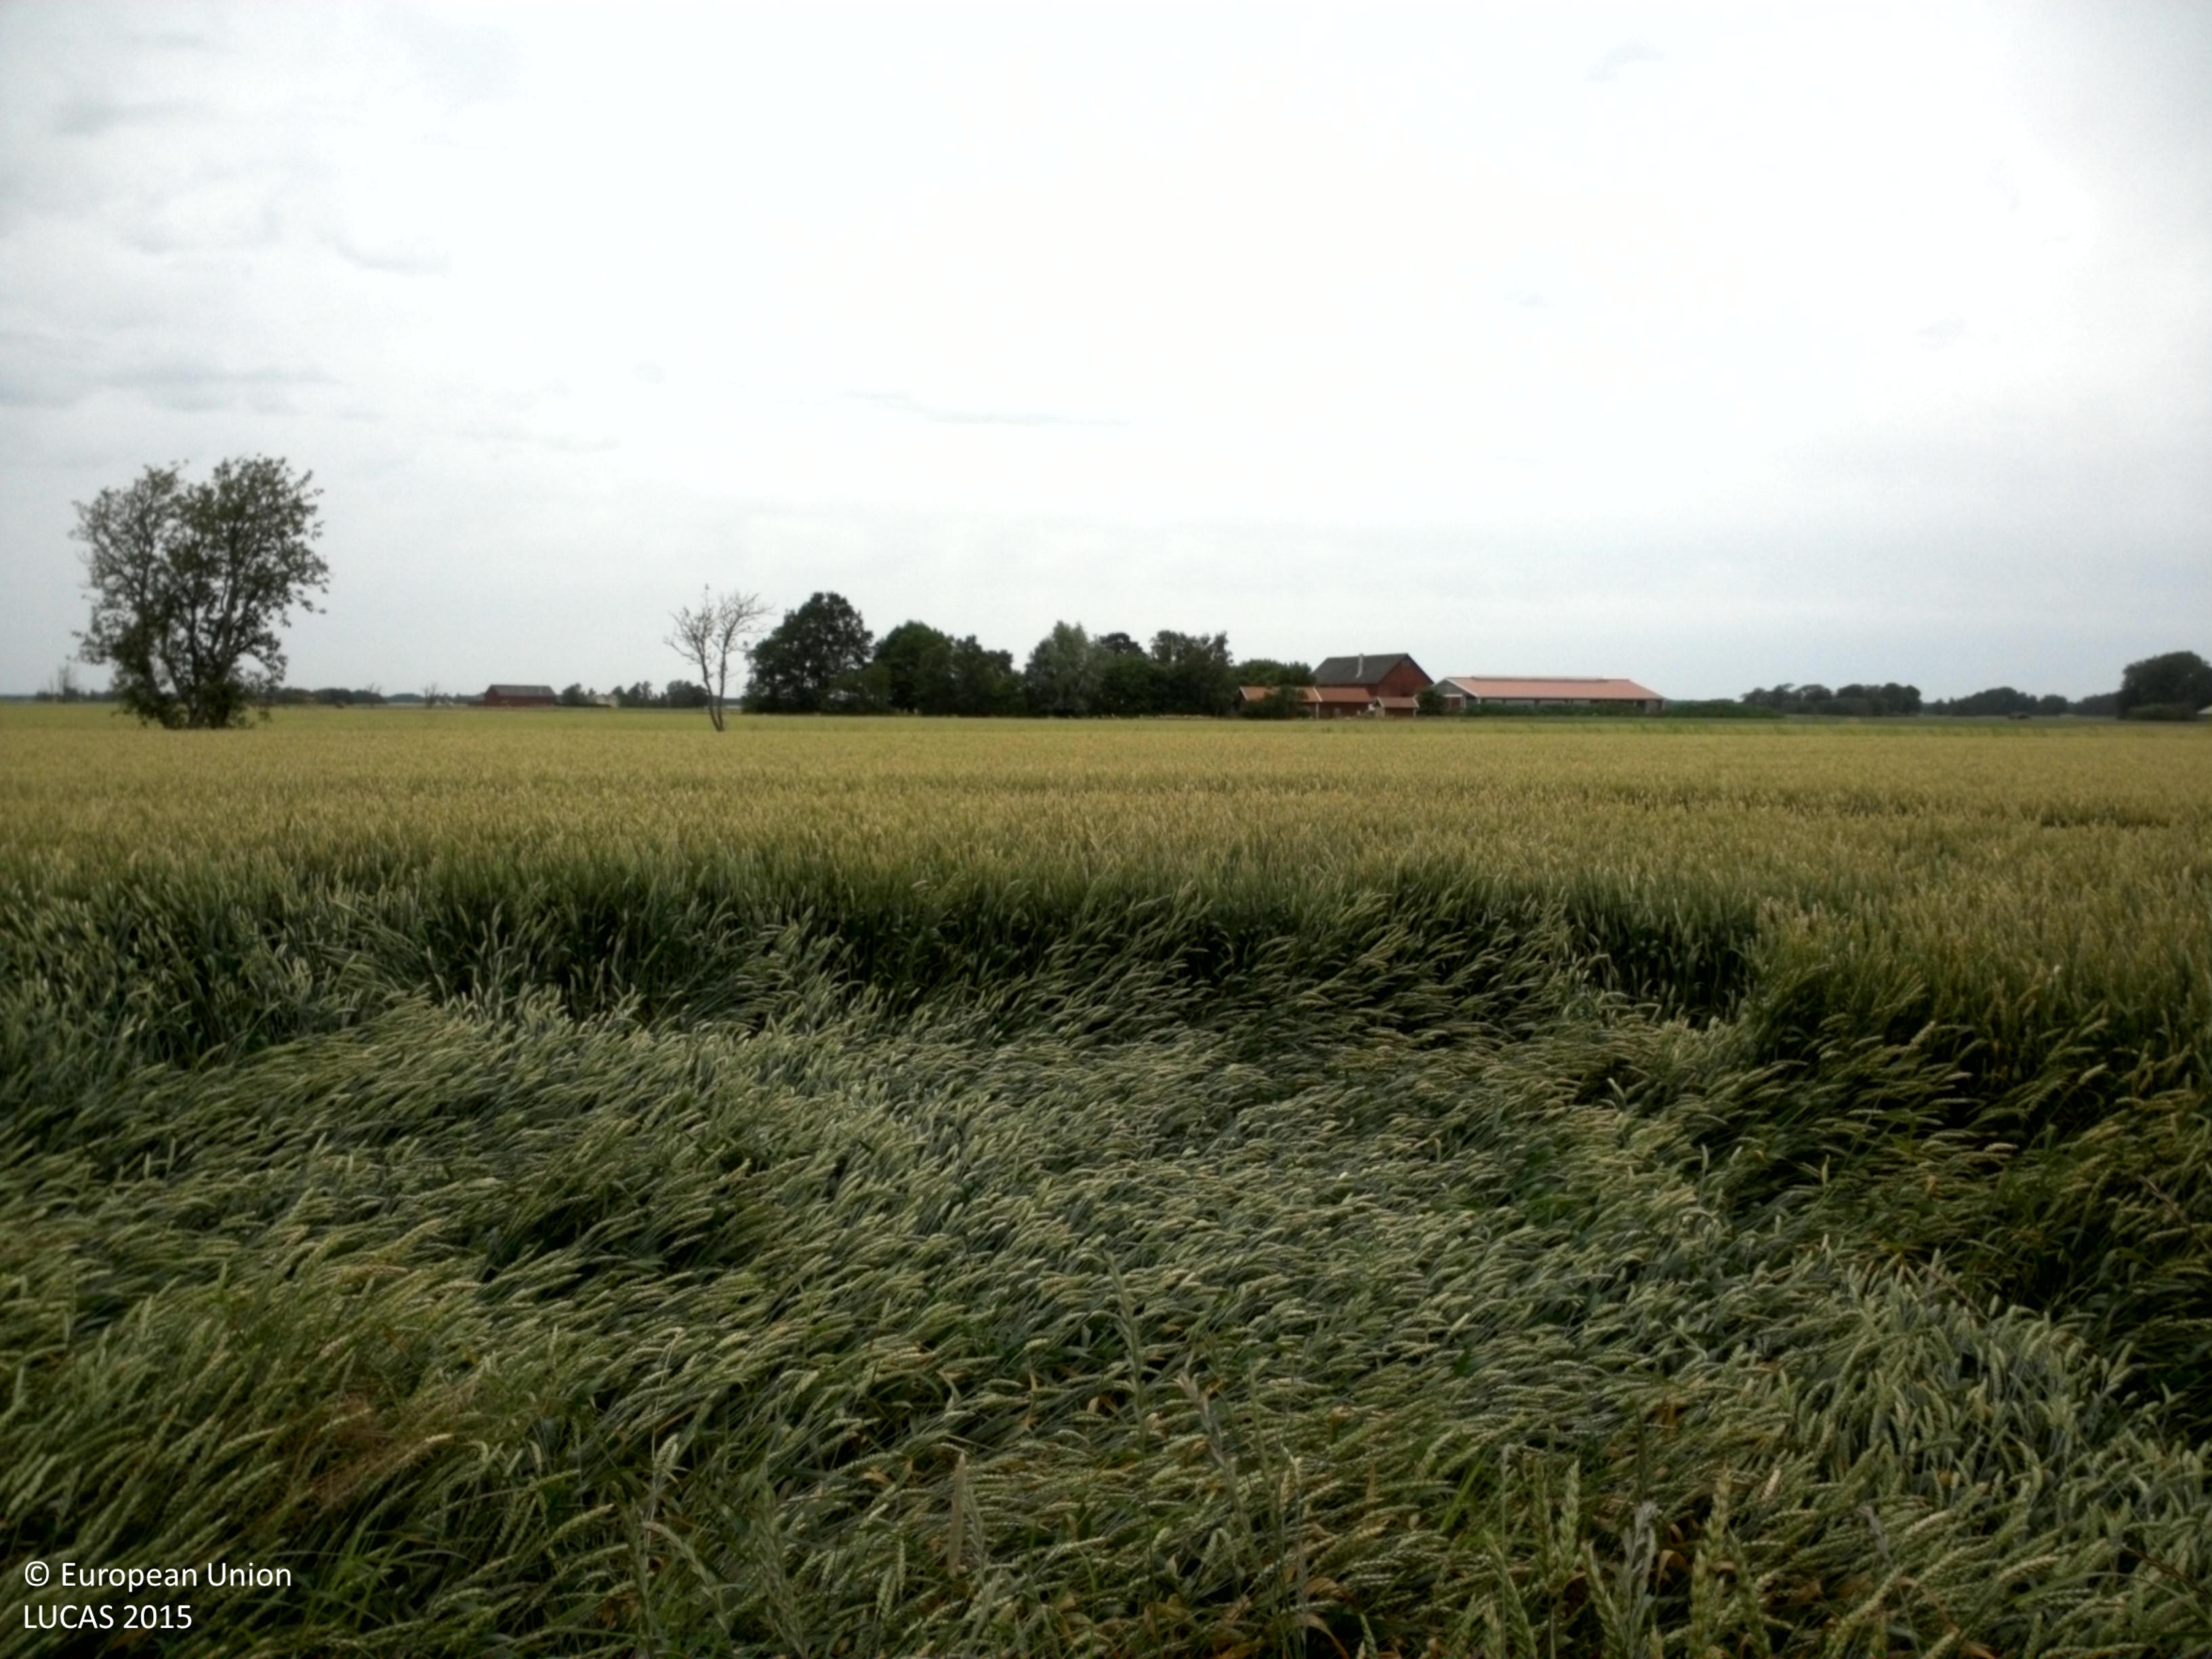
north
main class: Cropland
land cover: Common wheat
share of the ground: > 75 %
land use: Agriculture (excluding fallow land and kitchen gardens)
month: July
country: SE
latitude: 58.3780
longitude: 13.2604
